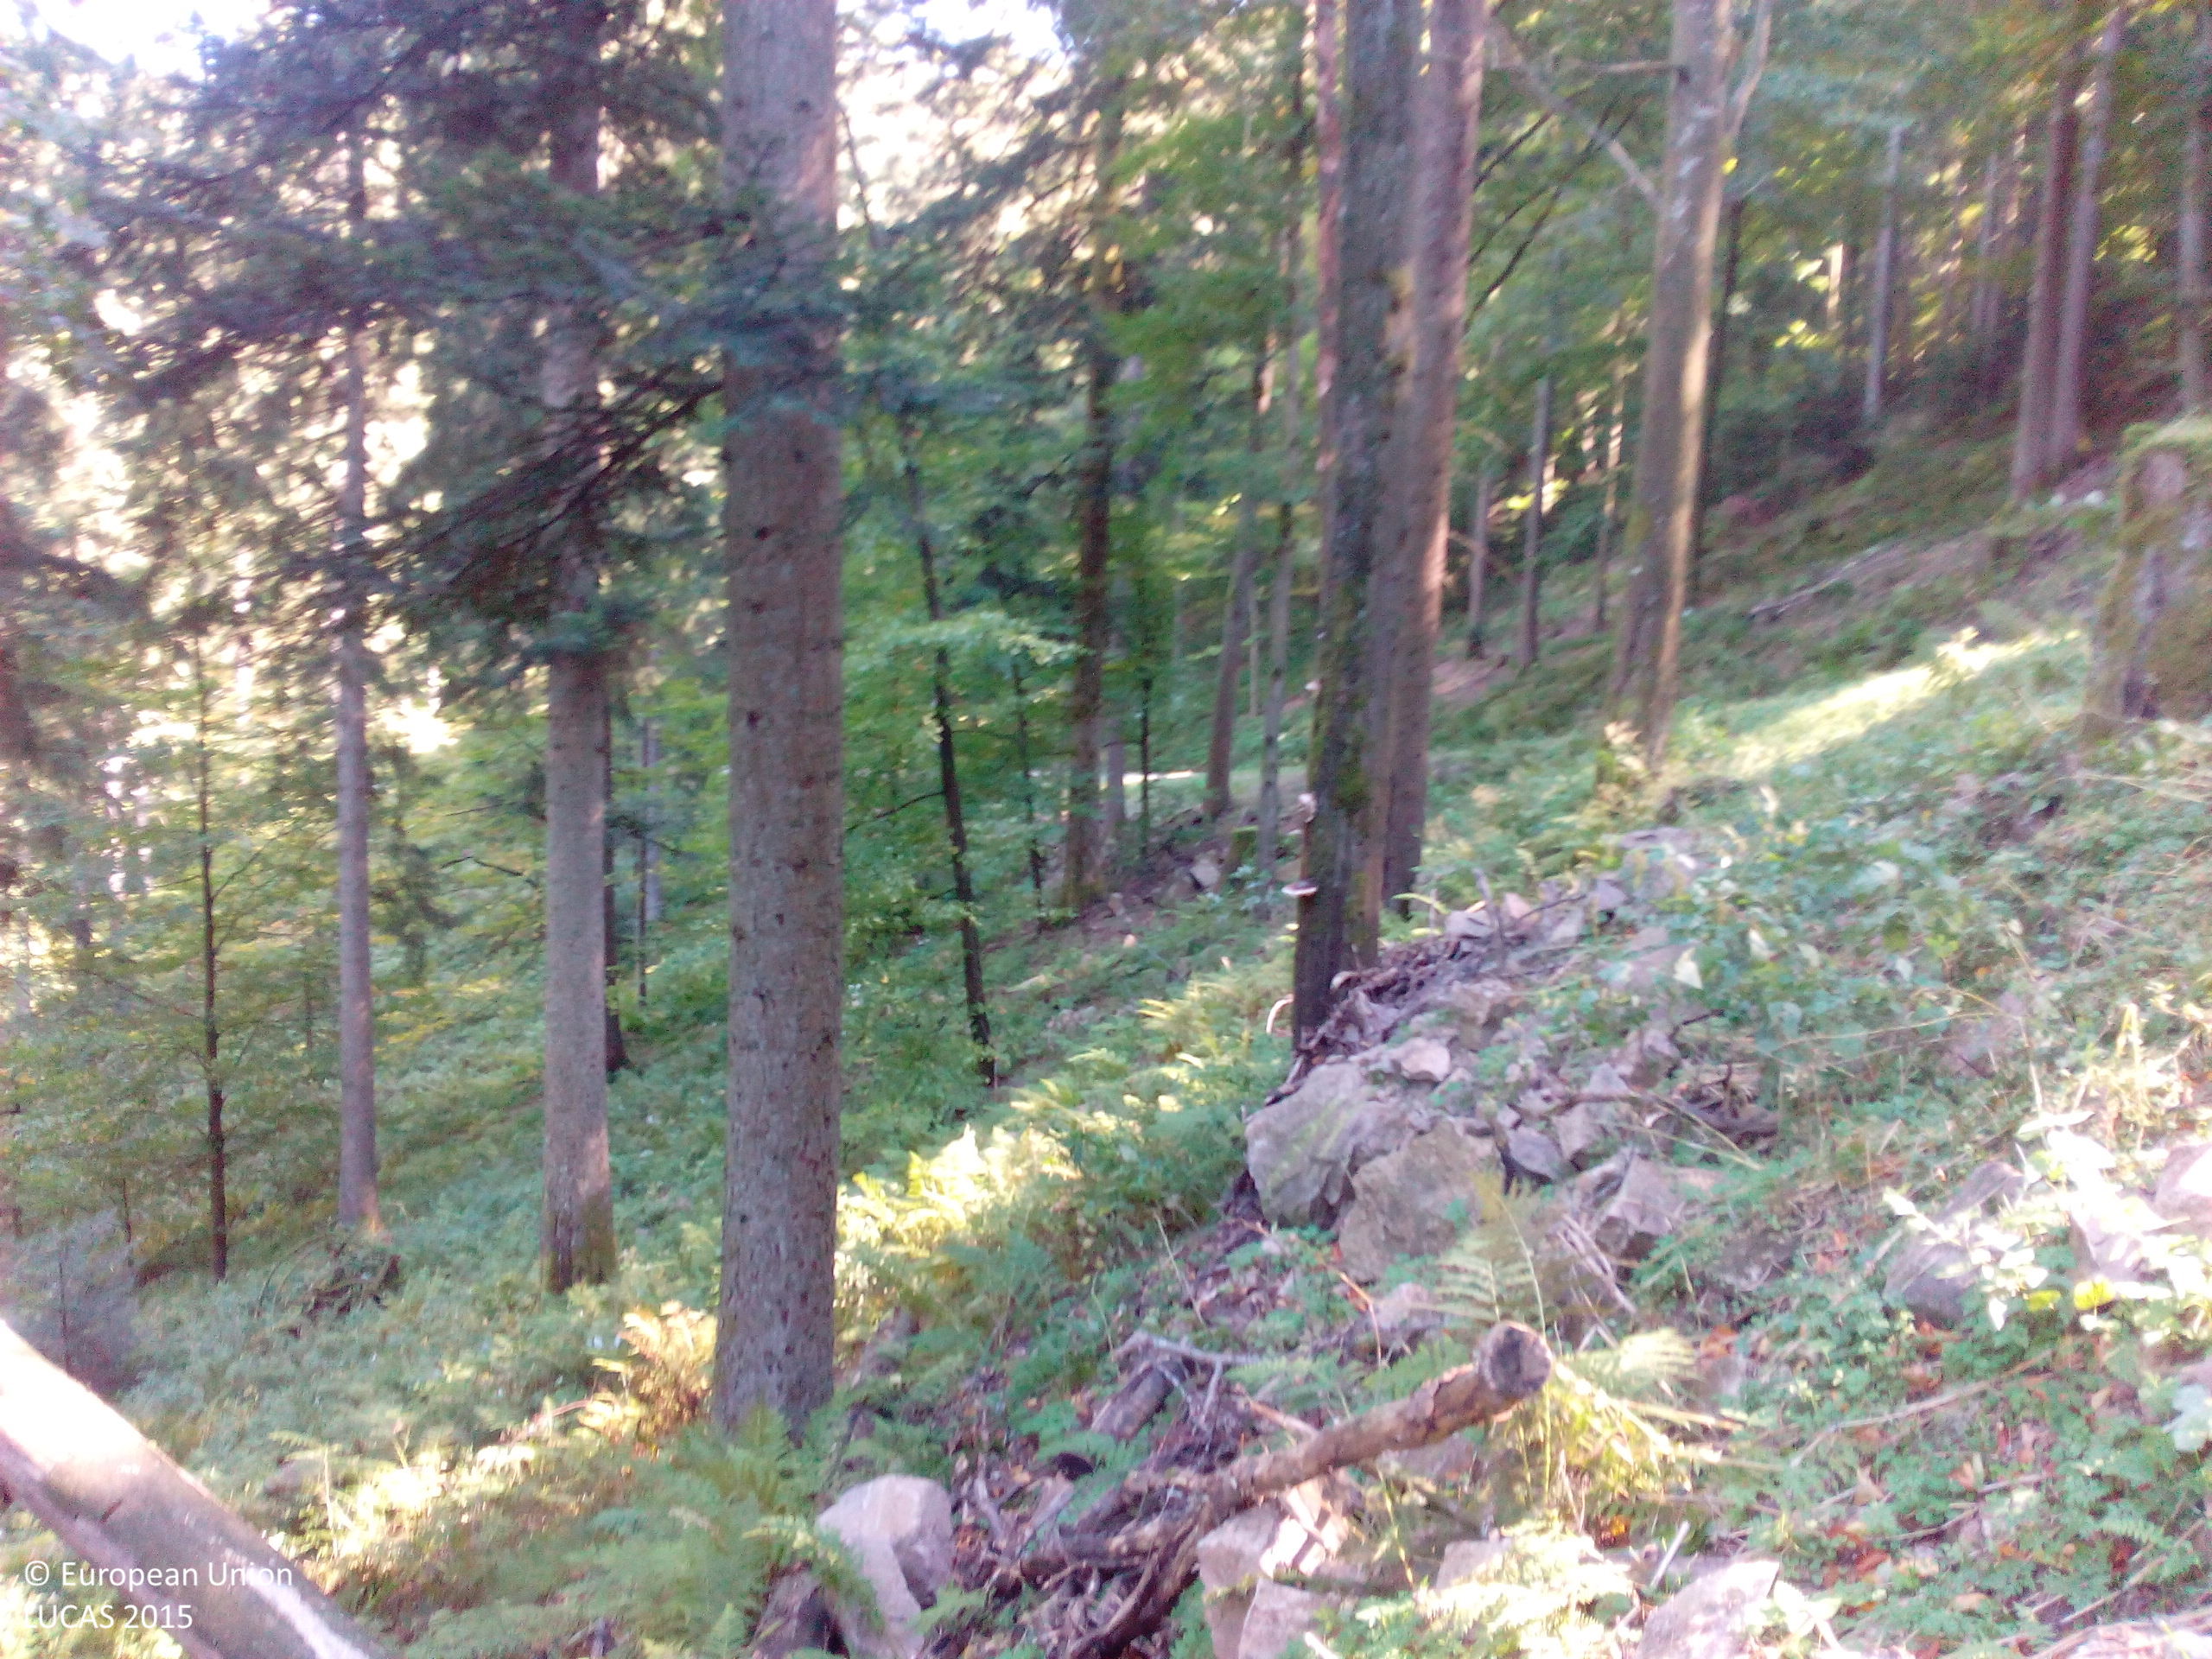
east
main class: Woodland
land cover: Other mixed woodland
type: hemiboreal forest and nemoral coniferous forest and mixed broadleaved-coniferous forest
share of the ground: 50 - 75 %
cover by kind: broadleaved forest trees 40 %, coniferous forest trees 30 %, shrubs 20 %, herbaceous plants 10 %
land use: Forestry
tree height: > 5 m
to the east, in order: Other mixed woodland; Spruce dominated mixed woodland; Paved roads, cycling and walking lanes; Spruce dominated mixed woodland; Tracks; Spruce dominated mixed woodland; Rivers and streams; Spruce dominated mixed woodland; Tracks
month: September
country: DE
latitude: 48.6228
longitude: 8.1964
